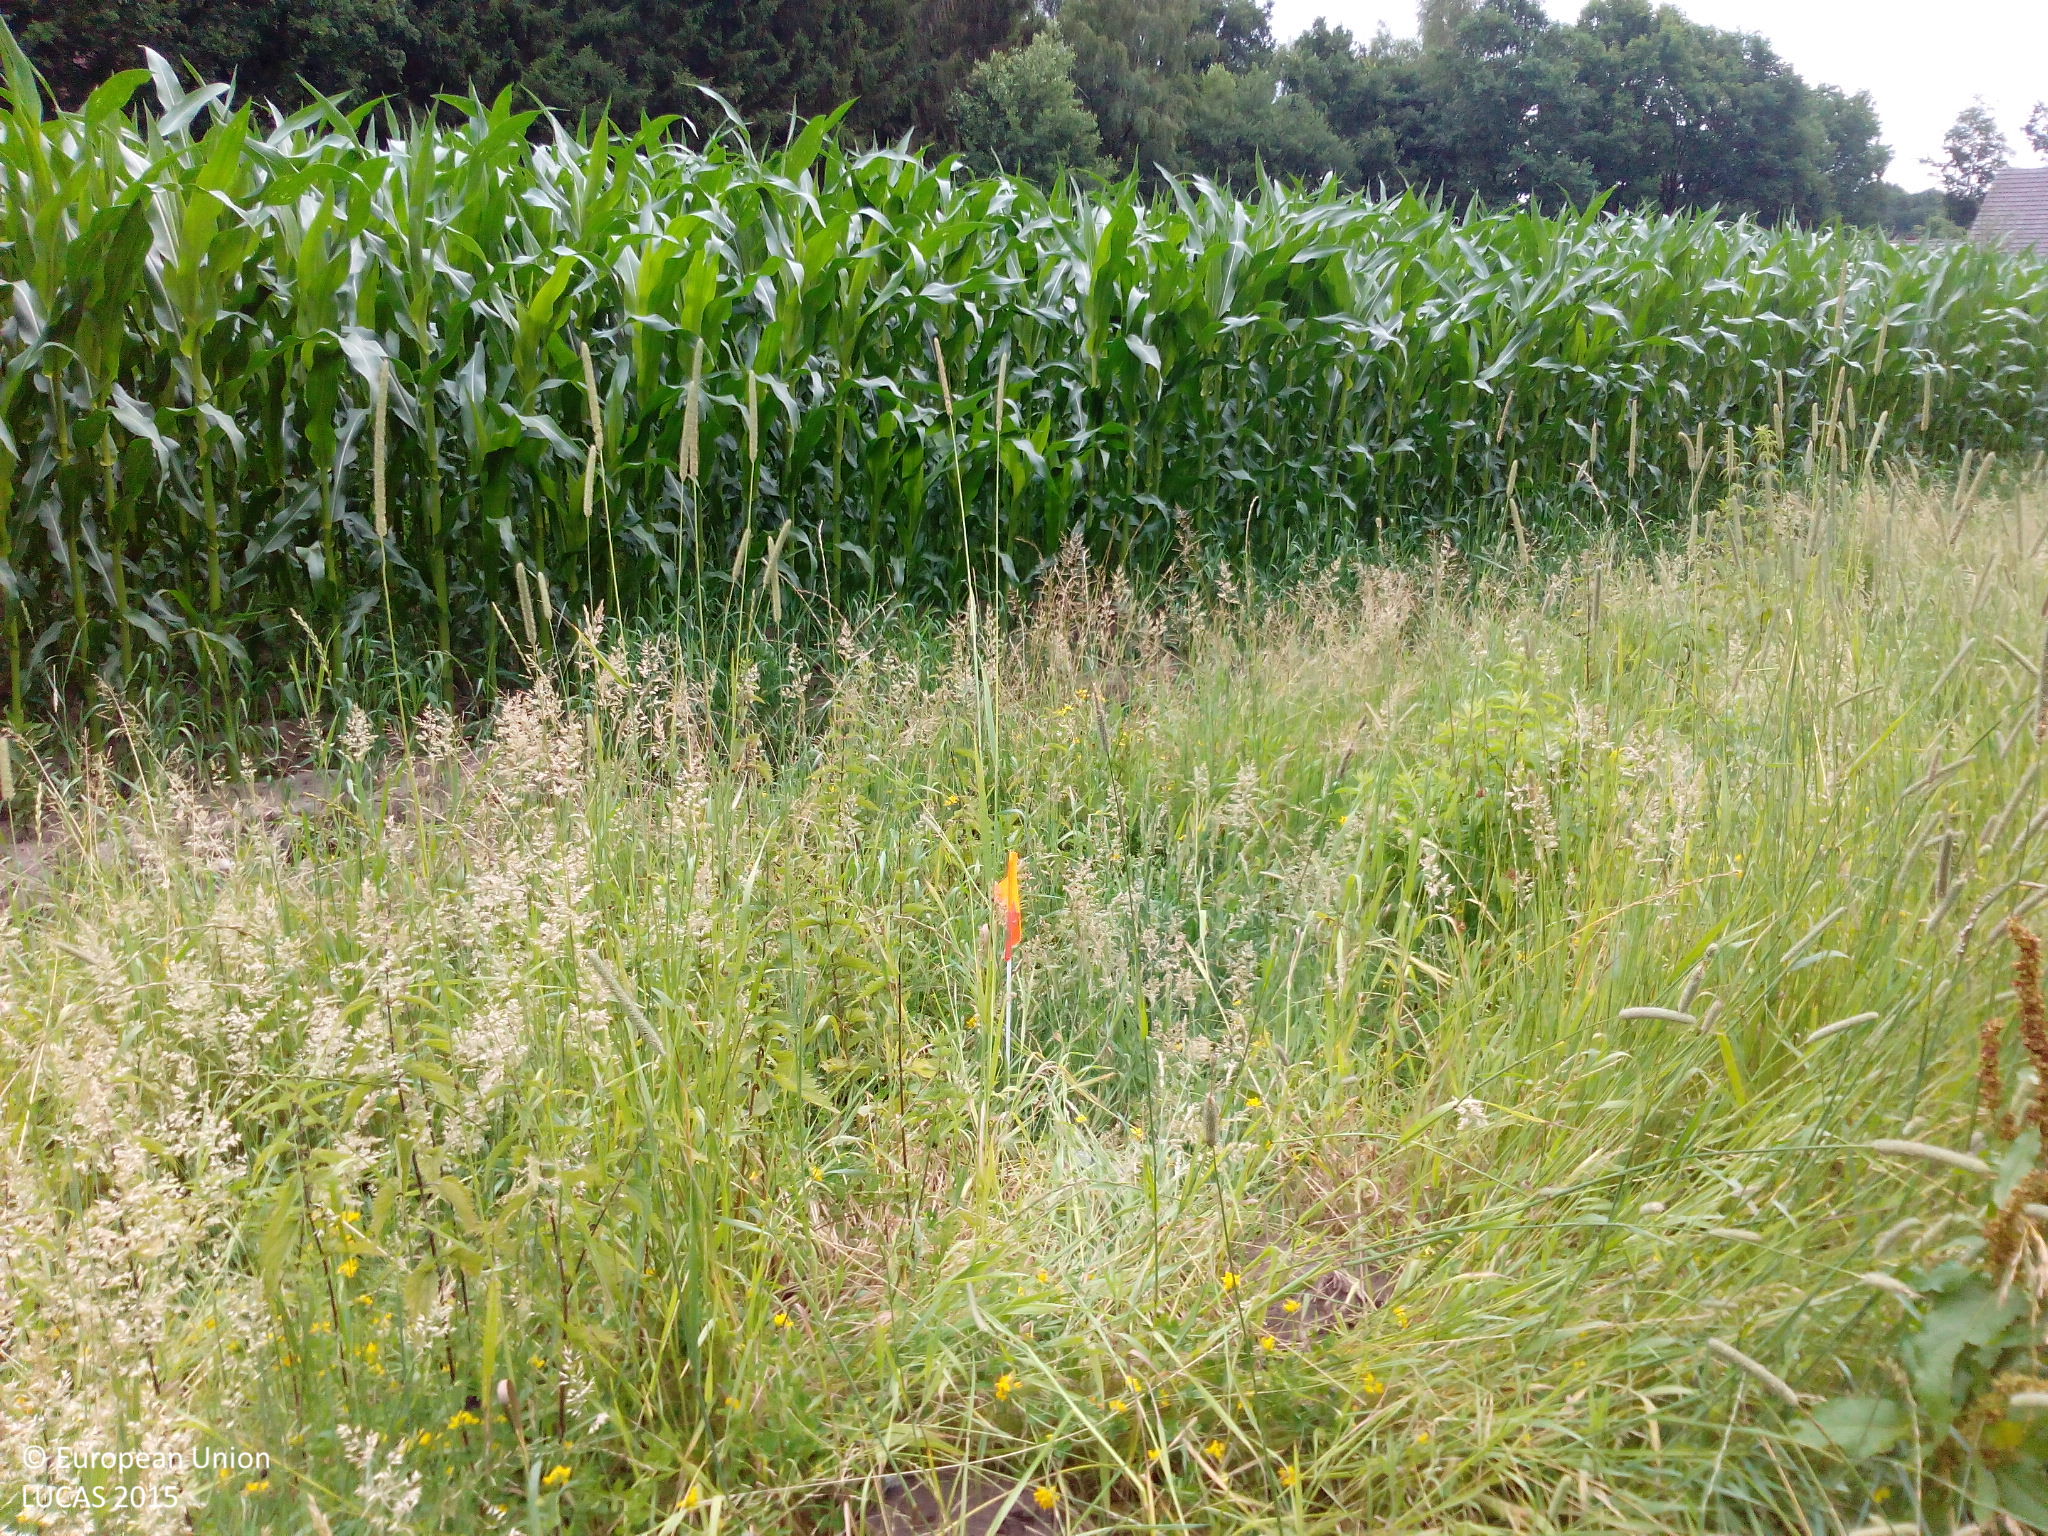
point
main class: Grassland
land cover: Grassland without tree/shrub cover
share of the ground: > 75 %
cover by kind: herbaceous plants 100 %
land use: Agriculture (excluding fallow land and kitchen gardens)
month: July
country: DE
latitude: 51.8118
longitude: 8.5934
